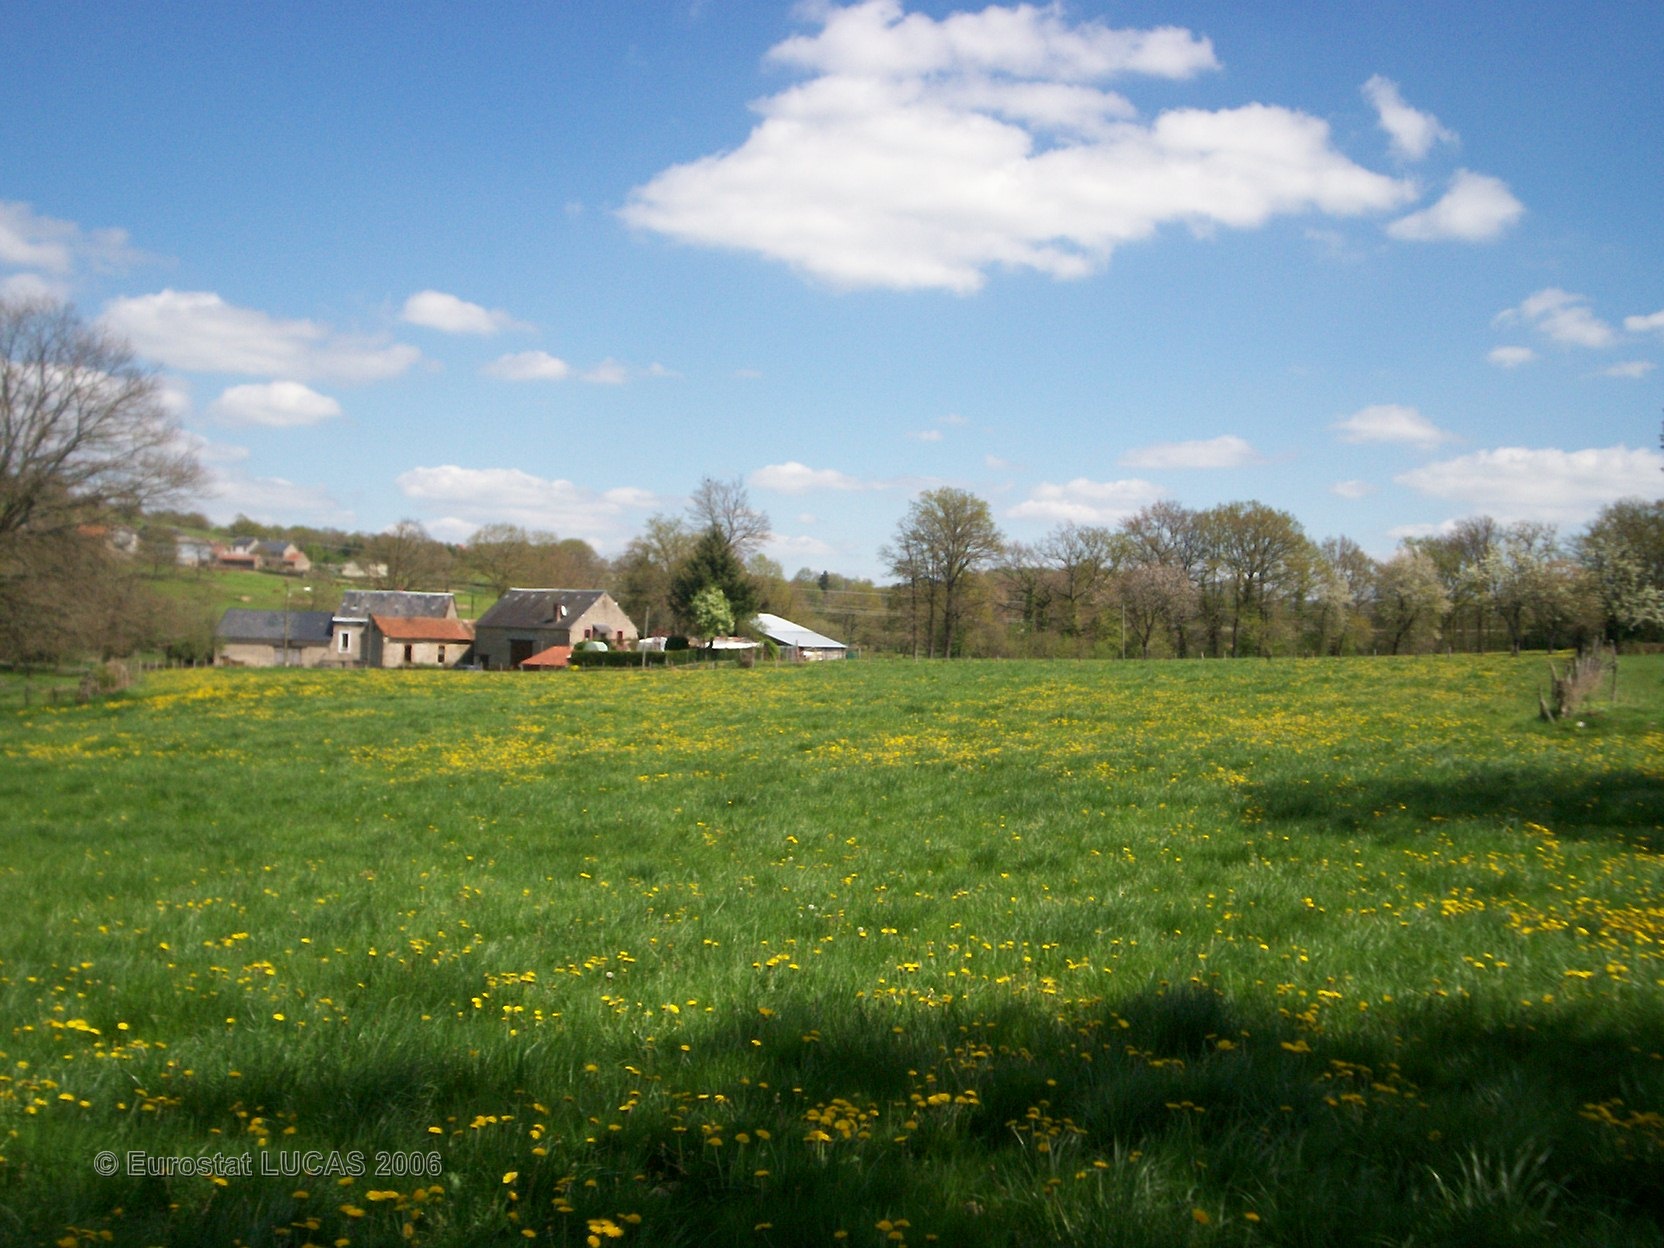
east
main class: Grassland
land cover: Grassland with sparse tree/shrub cover
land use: Agriculture (excluding fallow land and kitchen gardens)
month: April
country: FR
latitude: 46.2596
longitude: 1.6497
